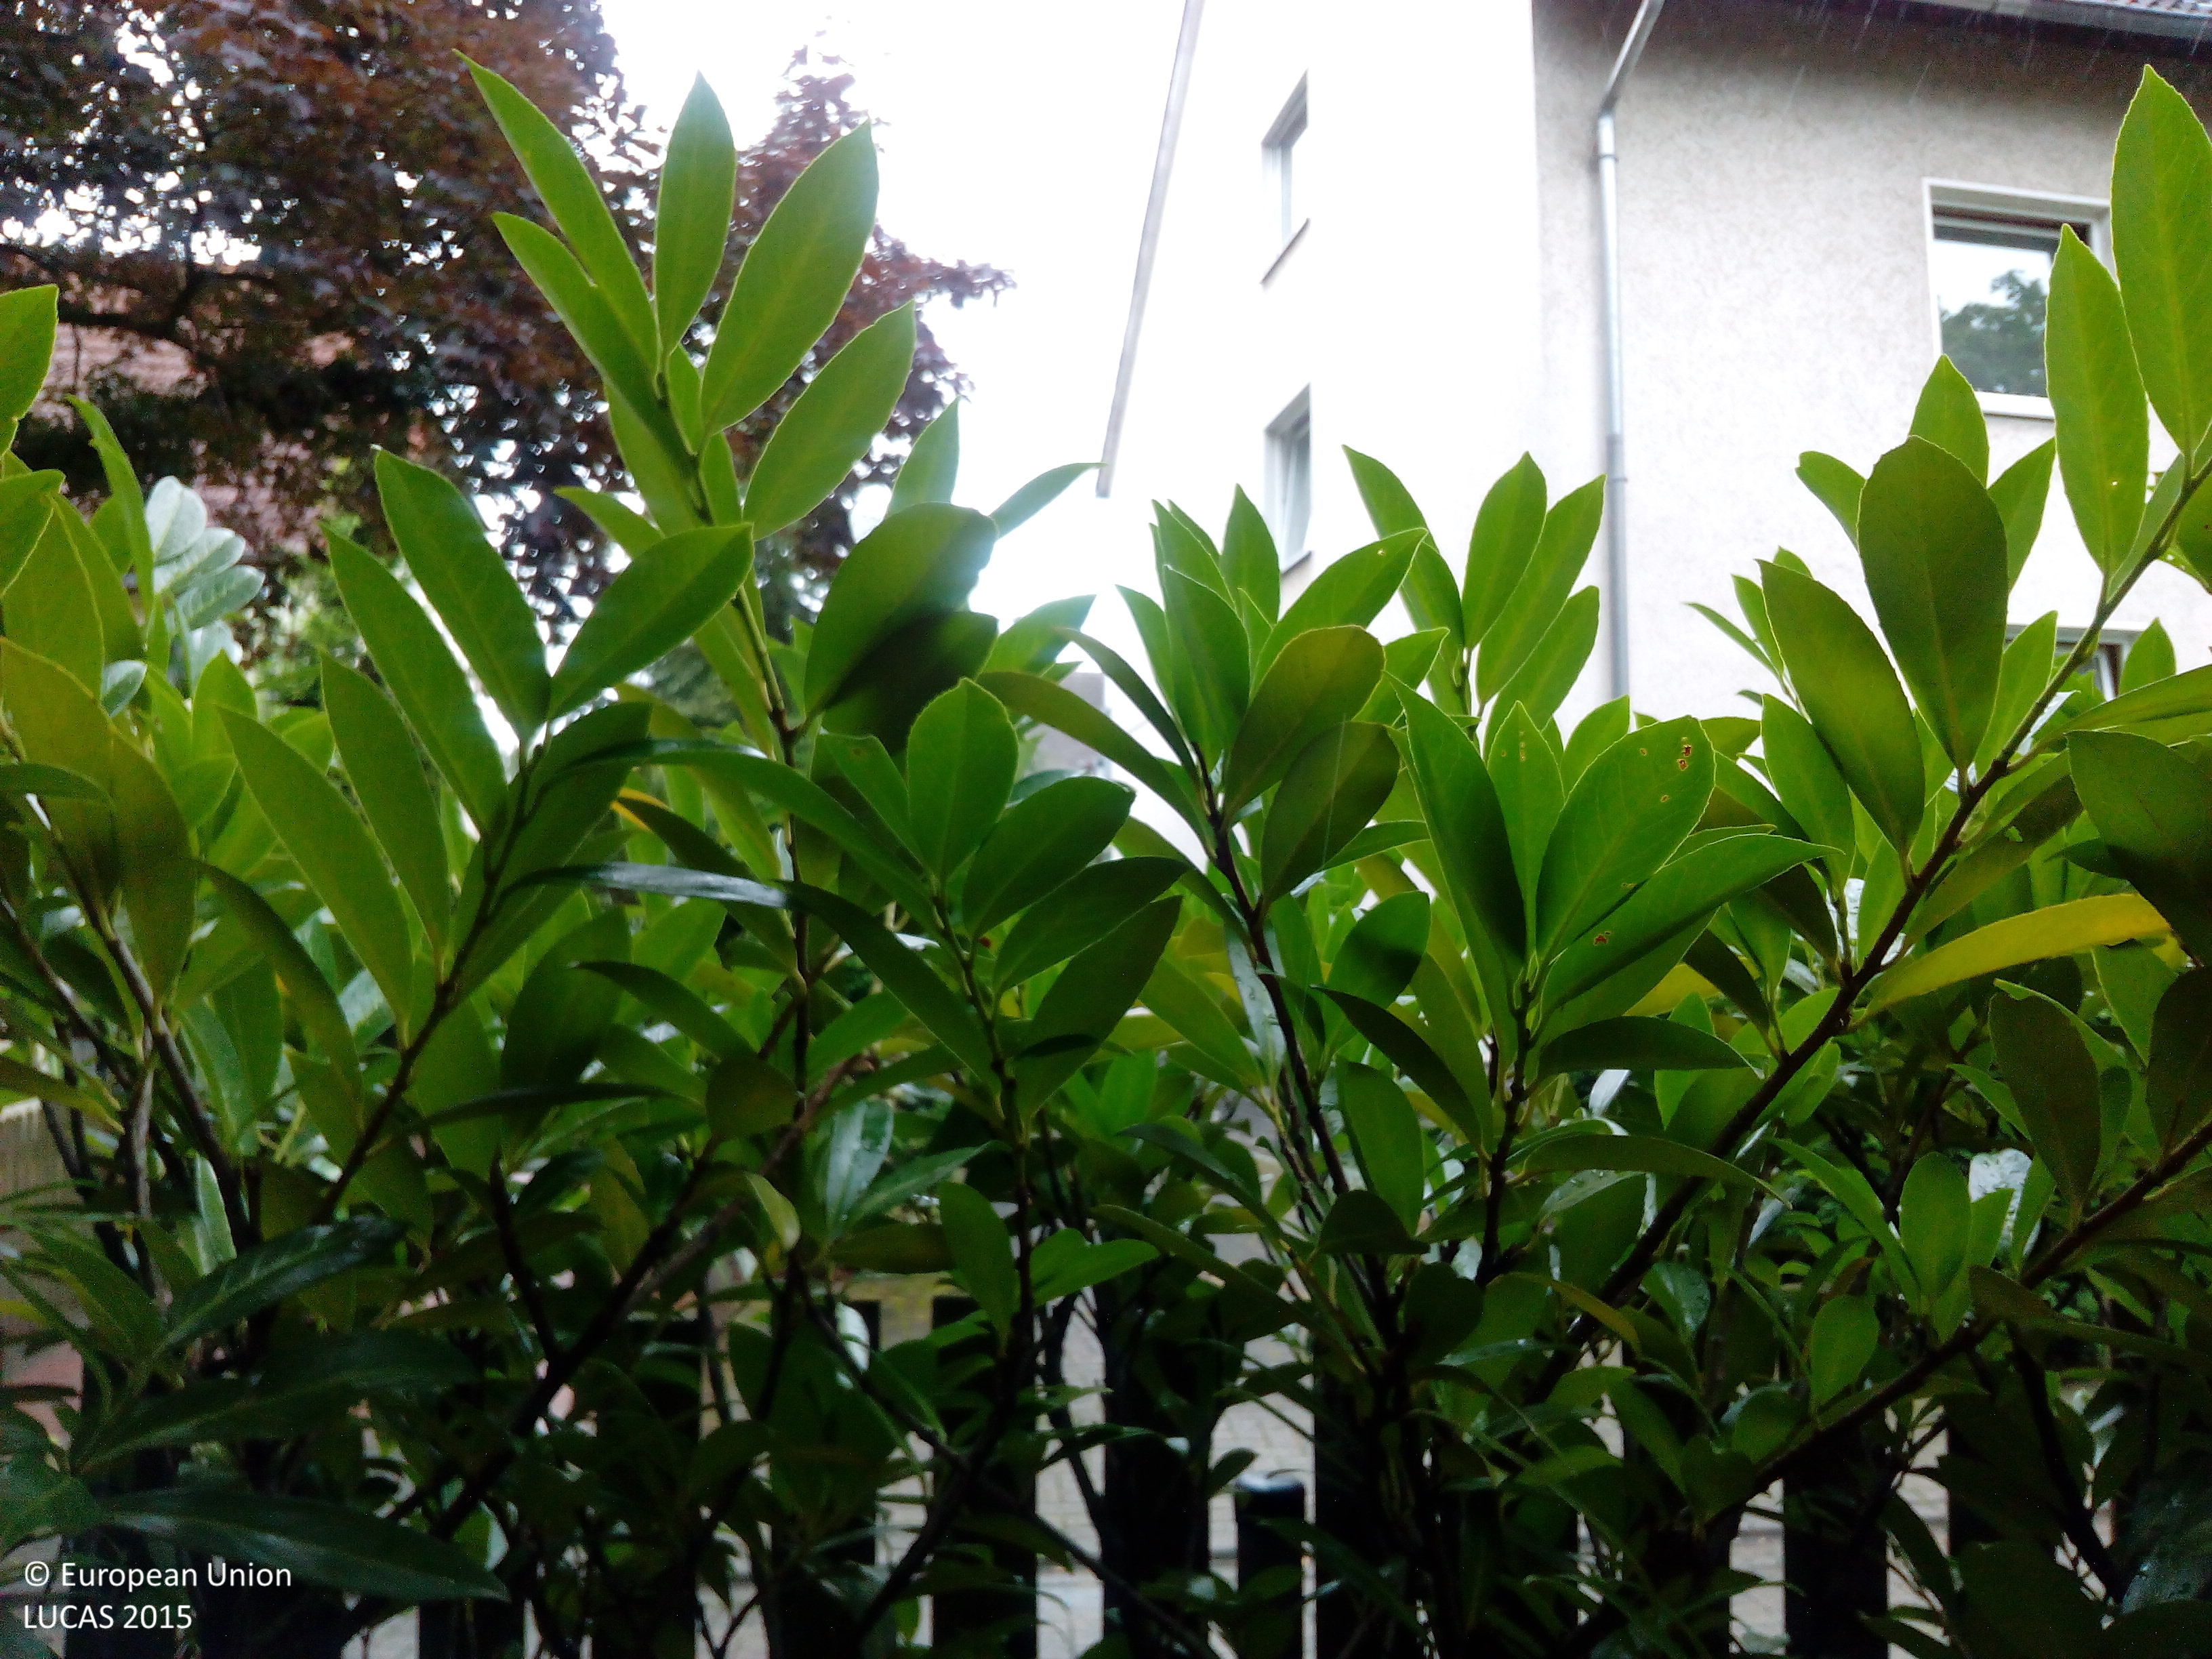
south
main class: Cropland
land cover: Floriculture and ornamental plants
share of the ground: 50 - 75 %
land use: Residential
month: July
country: DE
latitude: 52.2711
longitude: 8.0221
